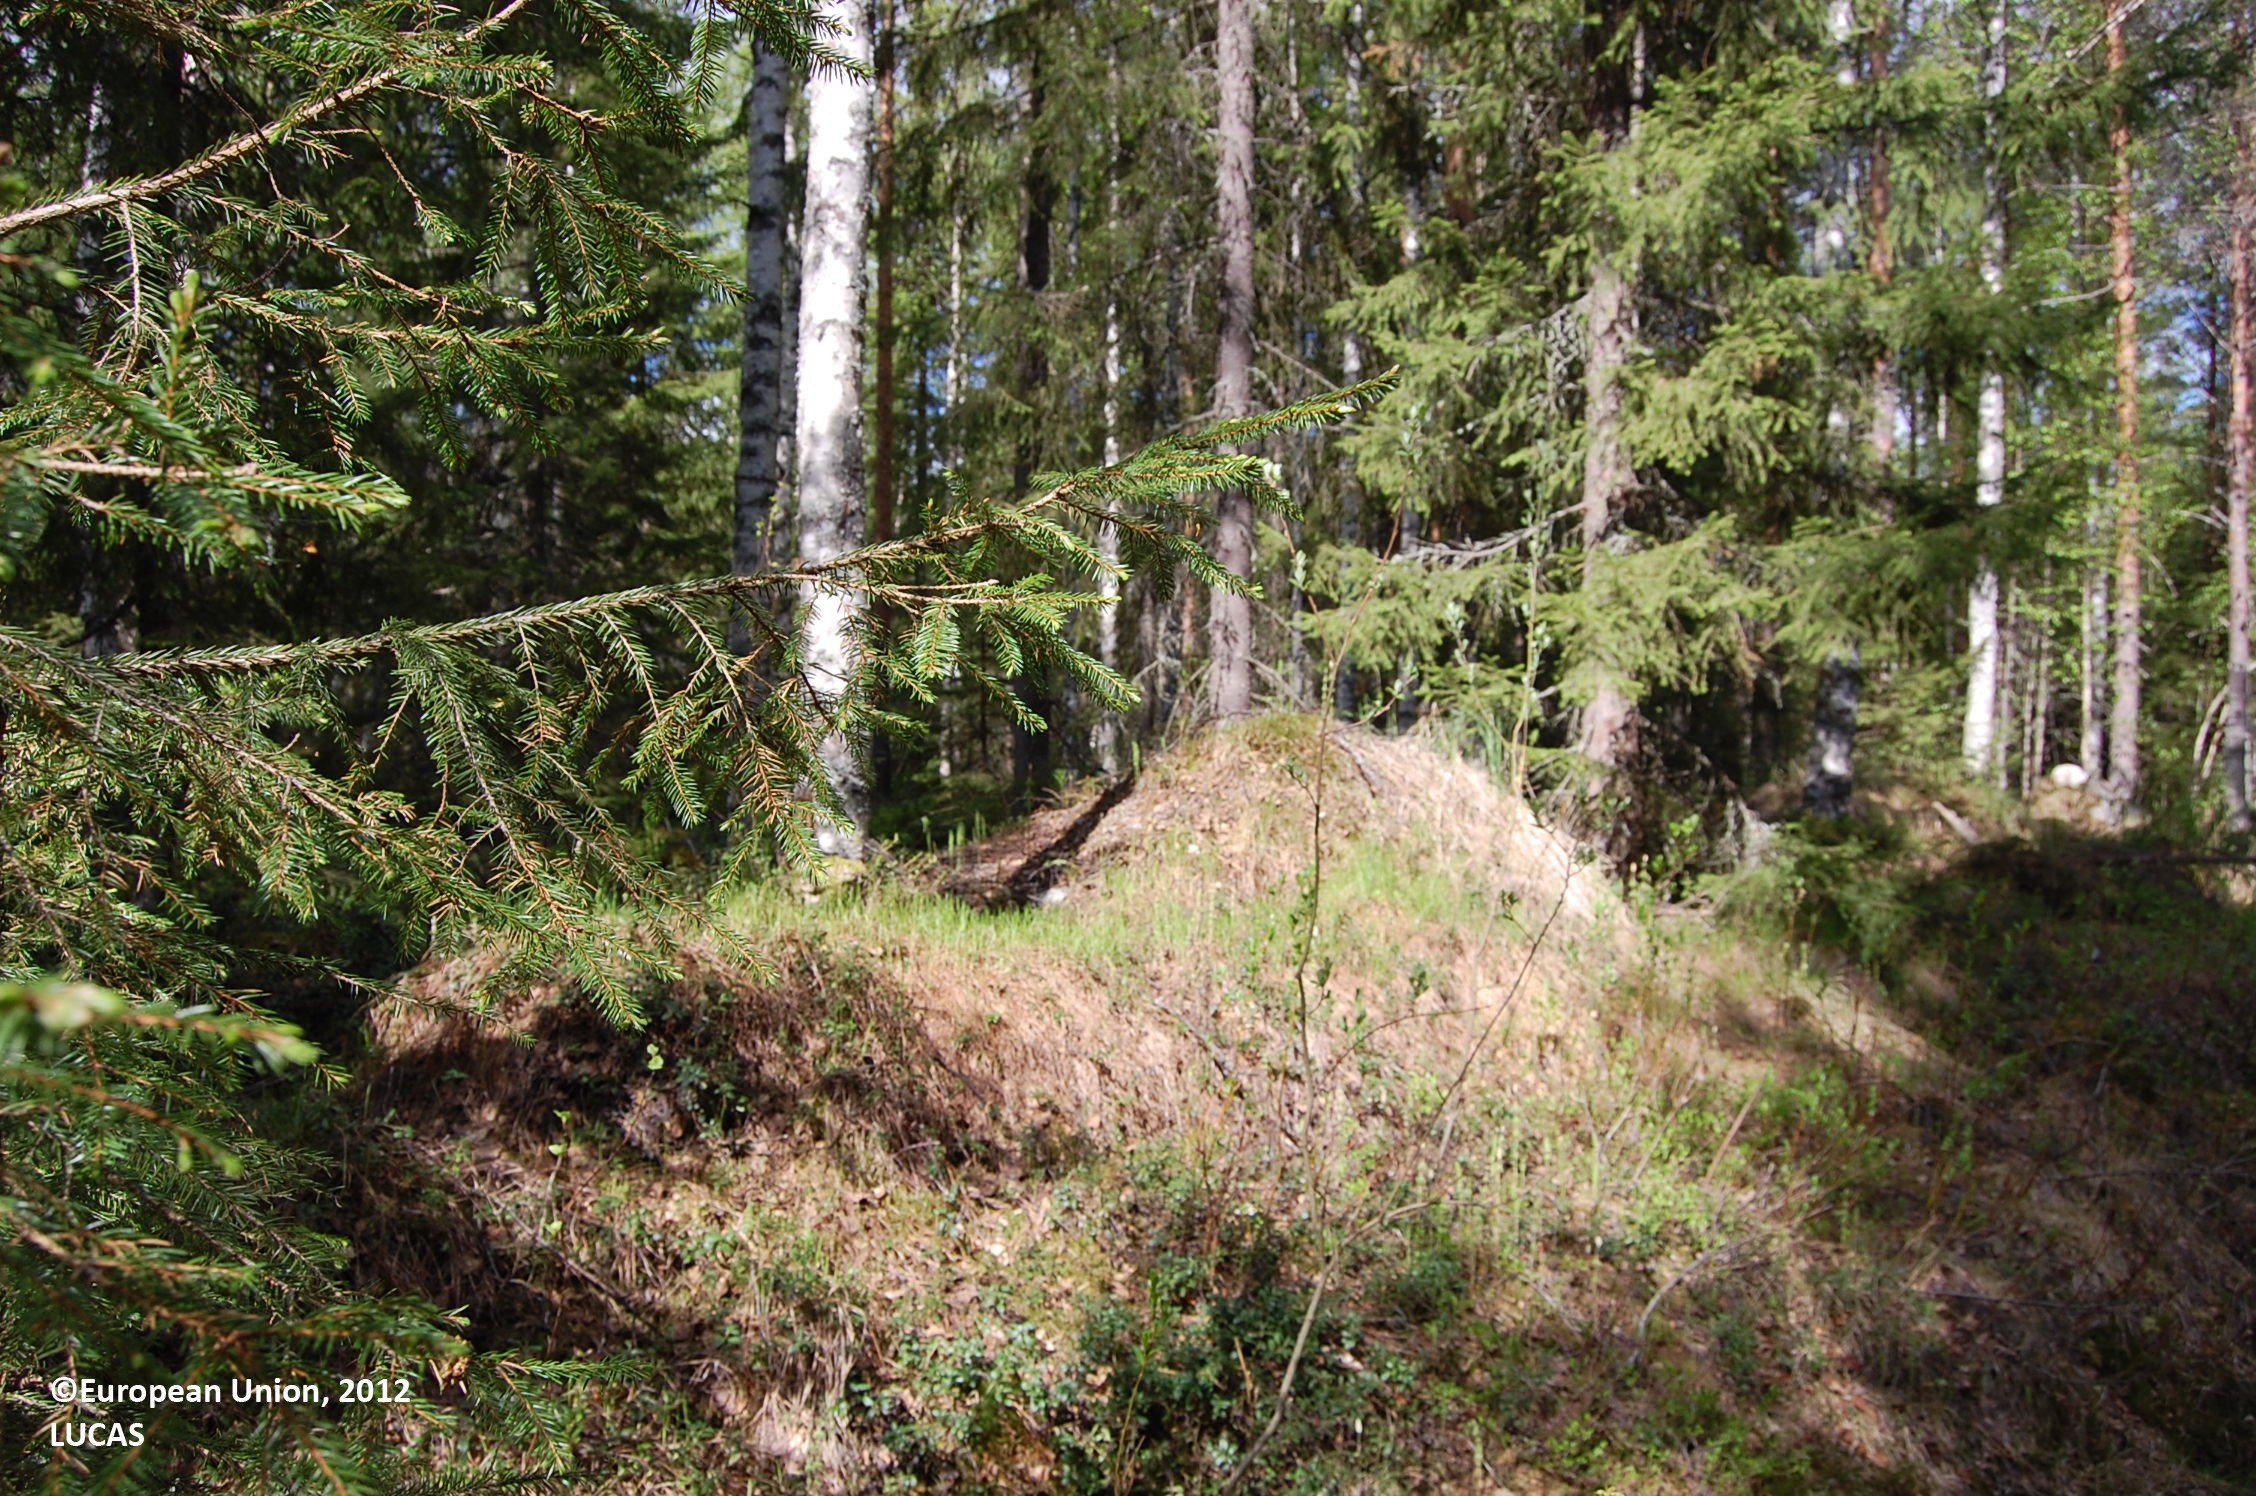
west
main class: Woodland
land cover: Other mixed woodland
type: boreal forest
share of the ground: > 75 %
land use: Forestry
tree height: > 5 m
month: May
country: FI
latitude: 64.2933
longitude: 26.2480
